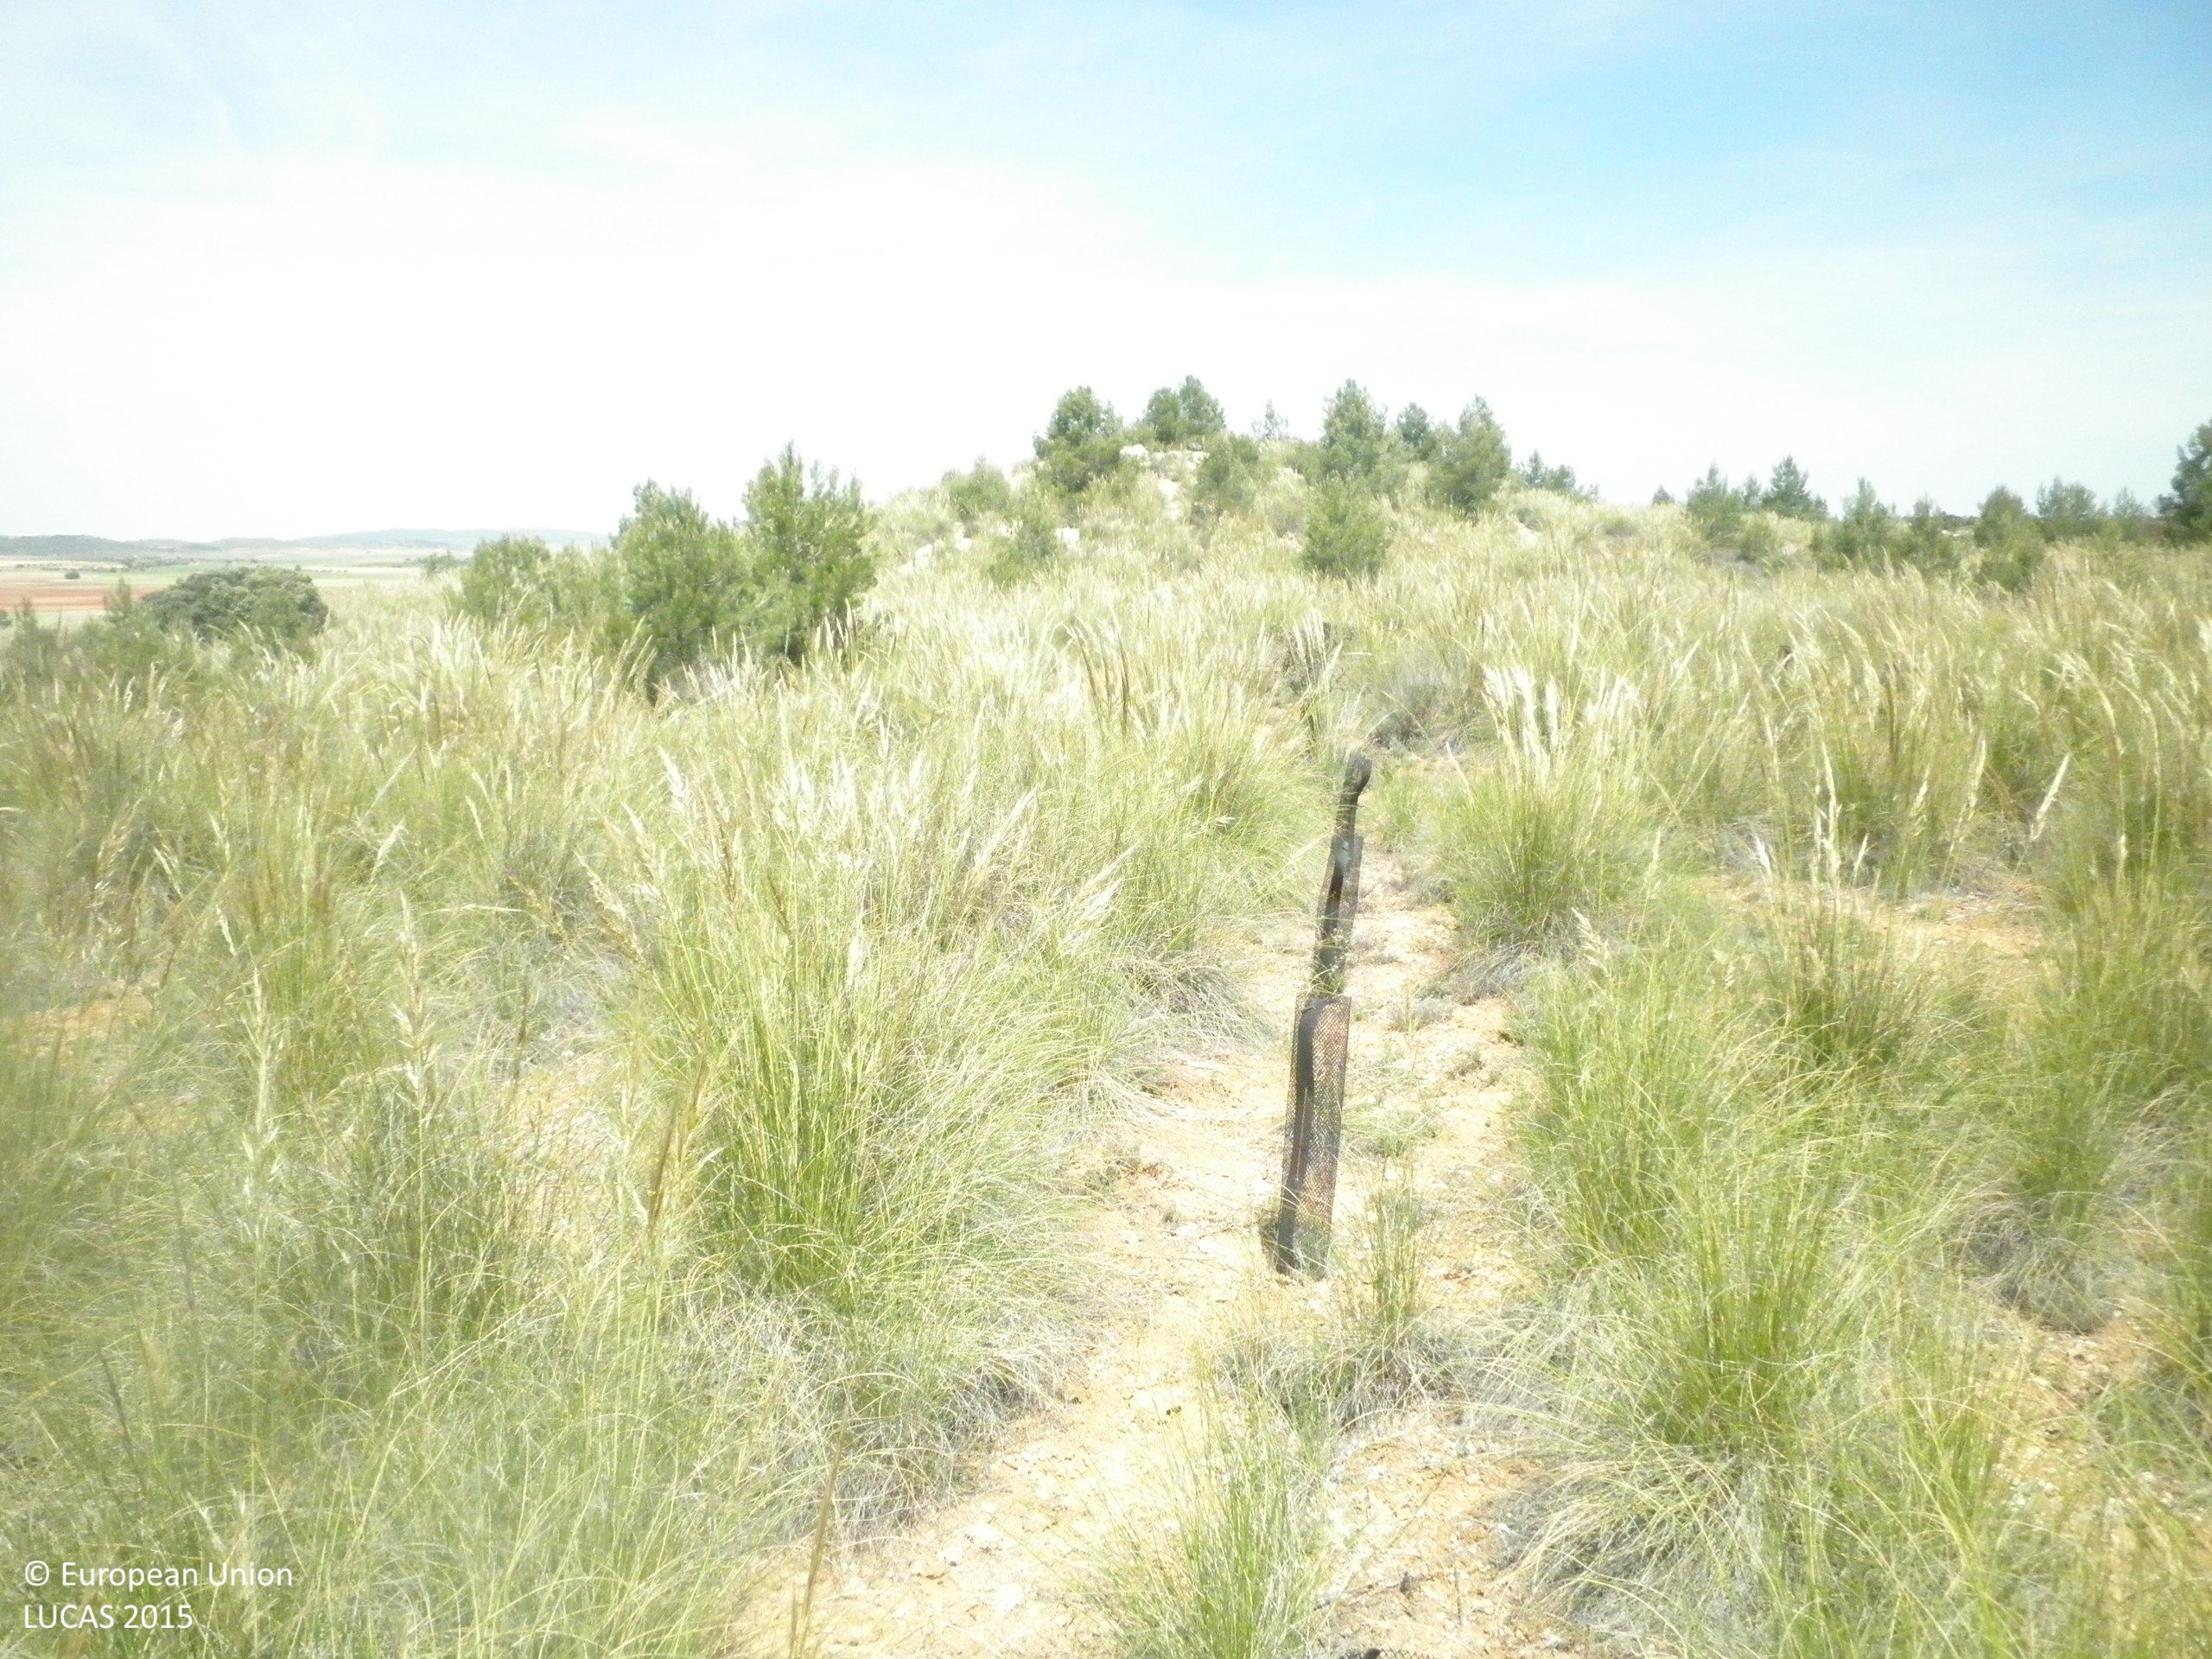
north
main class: Woodland
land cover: Broadleaved woodland
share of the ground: 10 - 25 %
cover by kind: unconsolidated bare surface 45 %, herbaceous plants 25 %, broadleaved forest trees 20 %, shrubs 10 %
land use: Semi-natural and natural areas not in use
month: May
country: ES
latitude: 39.6329
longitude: -2.7510
